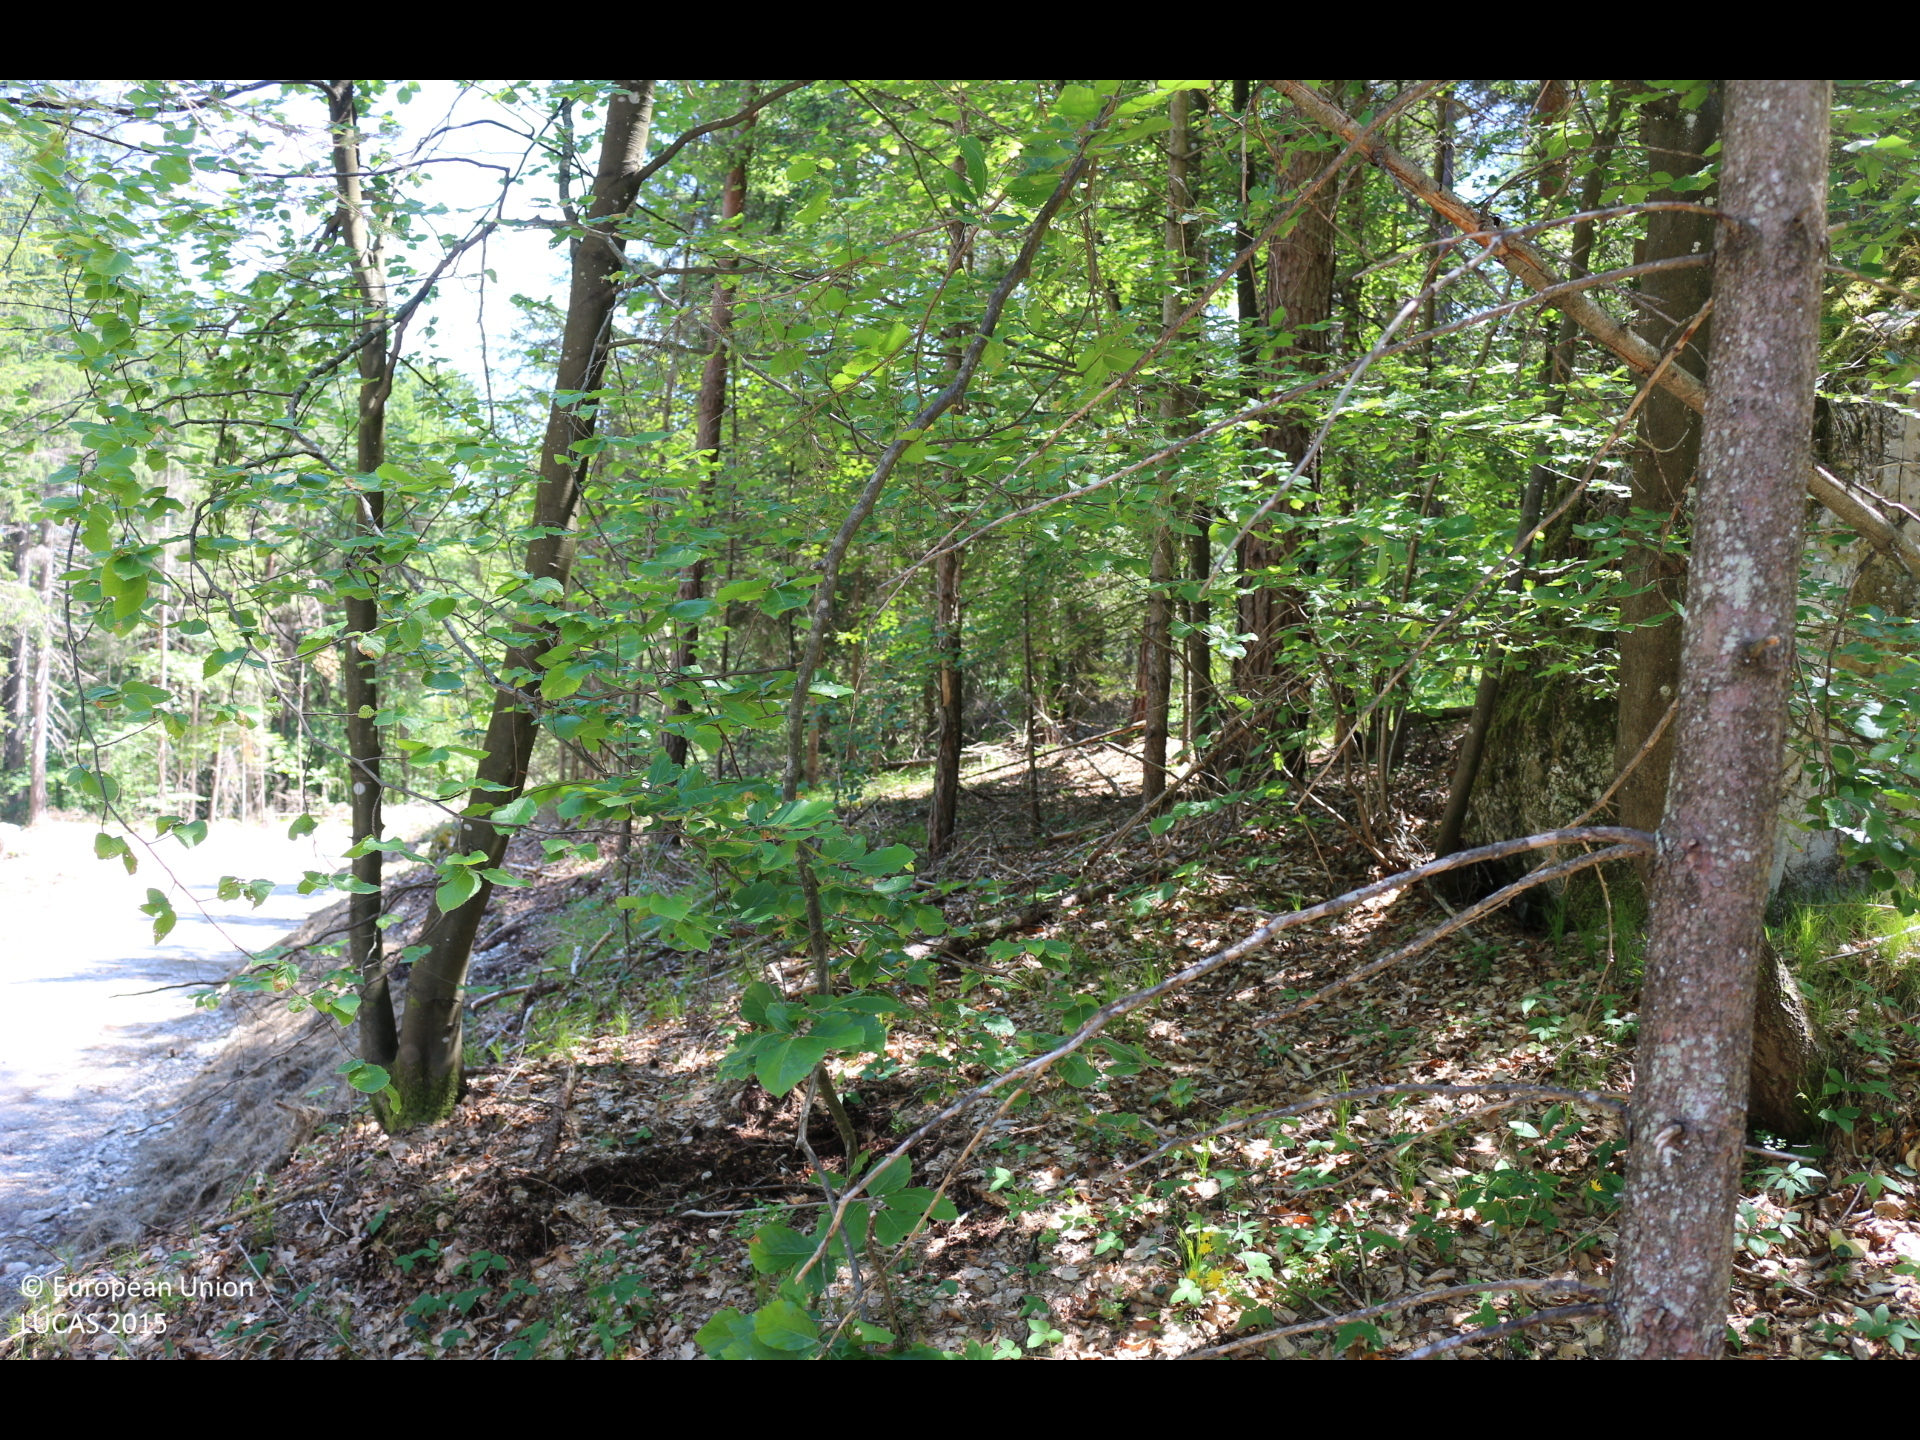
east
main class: Woodland
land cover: Spruce dominated mixed woodland
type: mountainous beech forest
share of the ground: > 75 %
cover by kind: coniferous forest trees 60 %, broadleaved forest trees 40 %
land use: Forestry
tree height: > 5 m
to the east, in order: Spruce dominated mixed woodland; Grass margins; Tracks; Spruce dominated mixed woodland; Artificial constructions in urban areas; Spruce dominated mixed woodland; Tracks; Grassland without tree/shrub cover; Tracks; Grassland with sparse tree/shrub cover
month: May
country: AT
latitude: 46.5260
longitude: 14.0776
